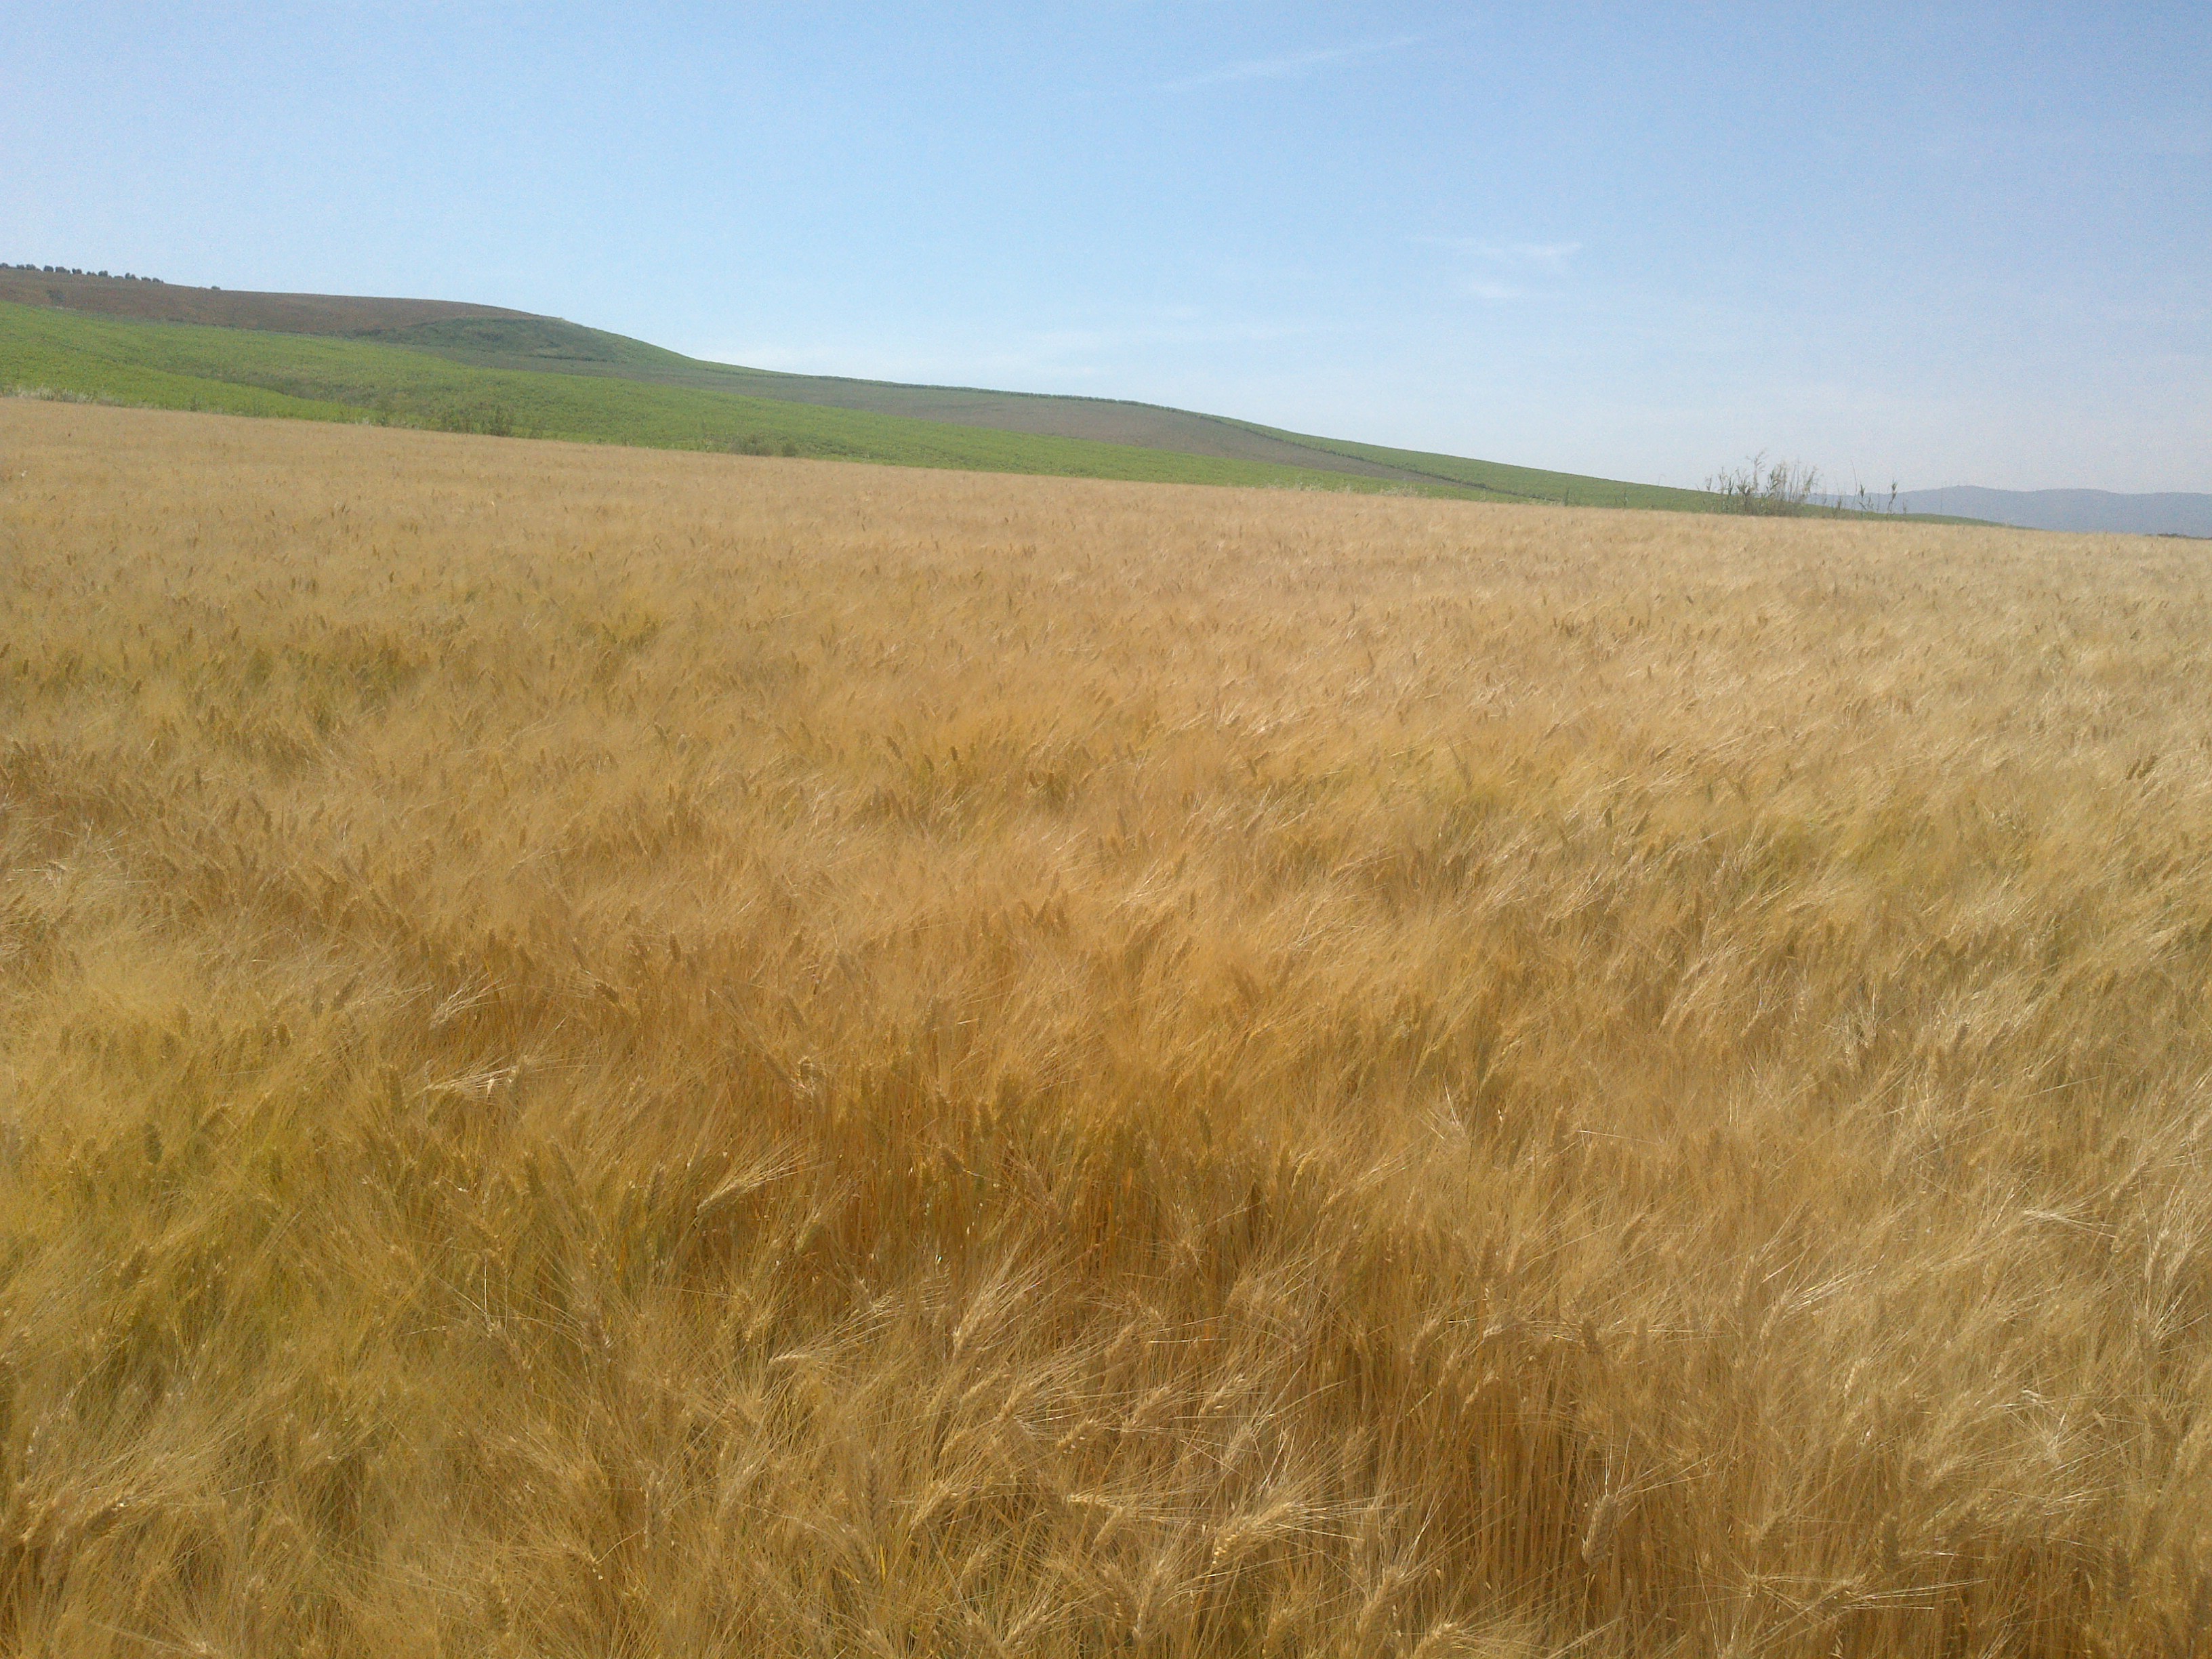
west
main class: Cropland
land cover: Durum wheat
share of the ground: > 75 %
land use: Agriculture (excluding fallow land and kitchen gardens)
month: May
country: ES
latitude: 37.8761
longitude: -4.6441
